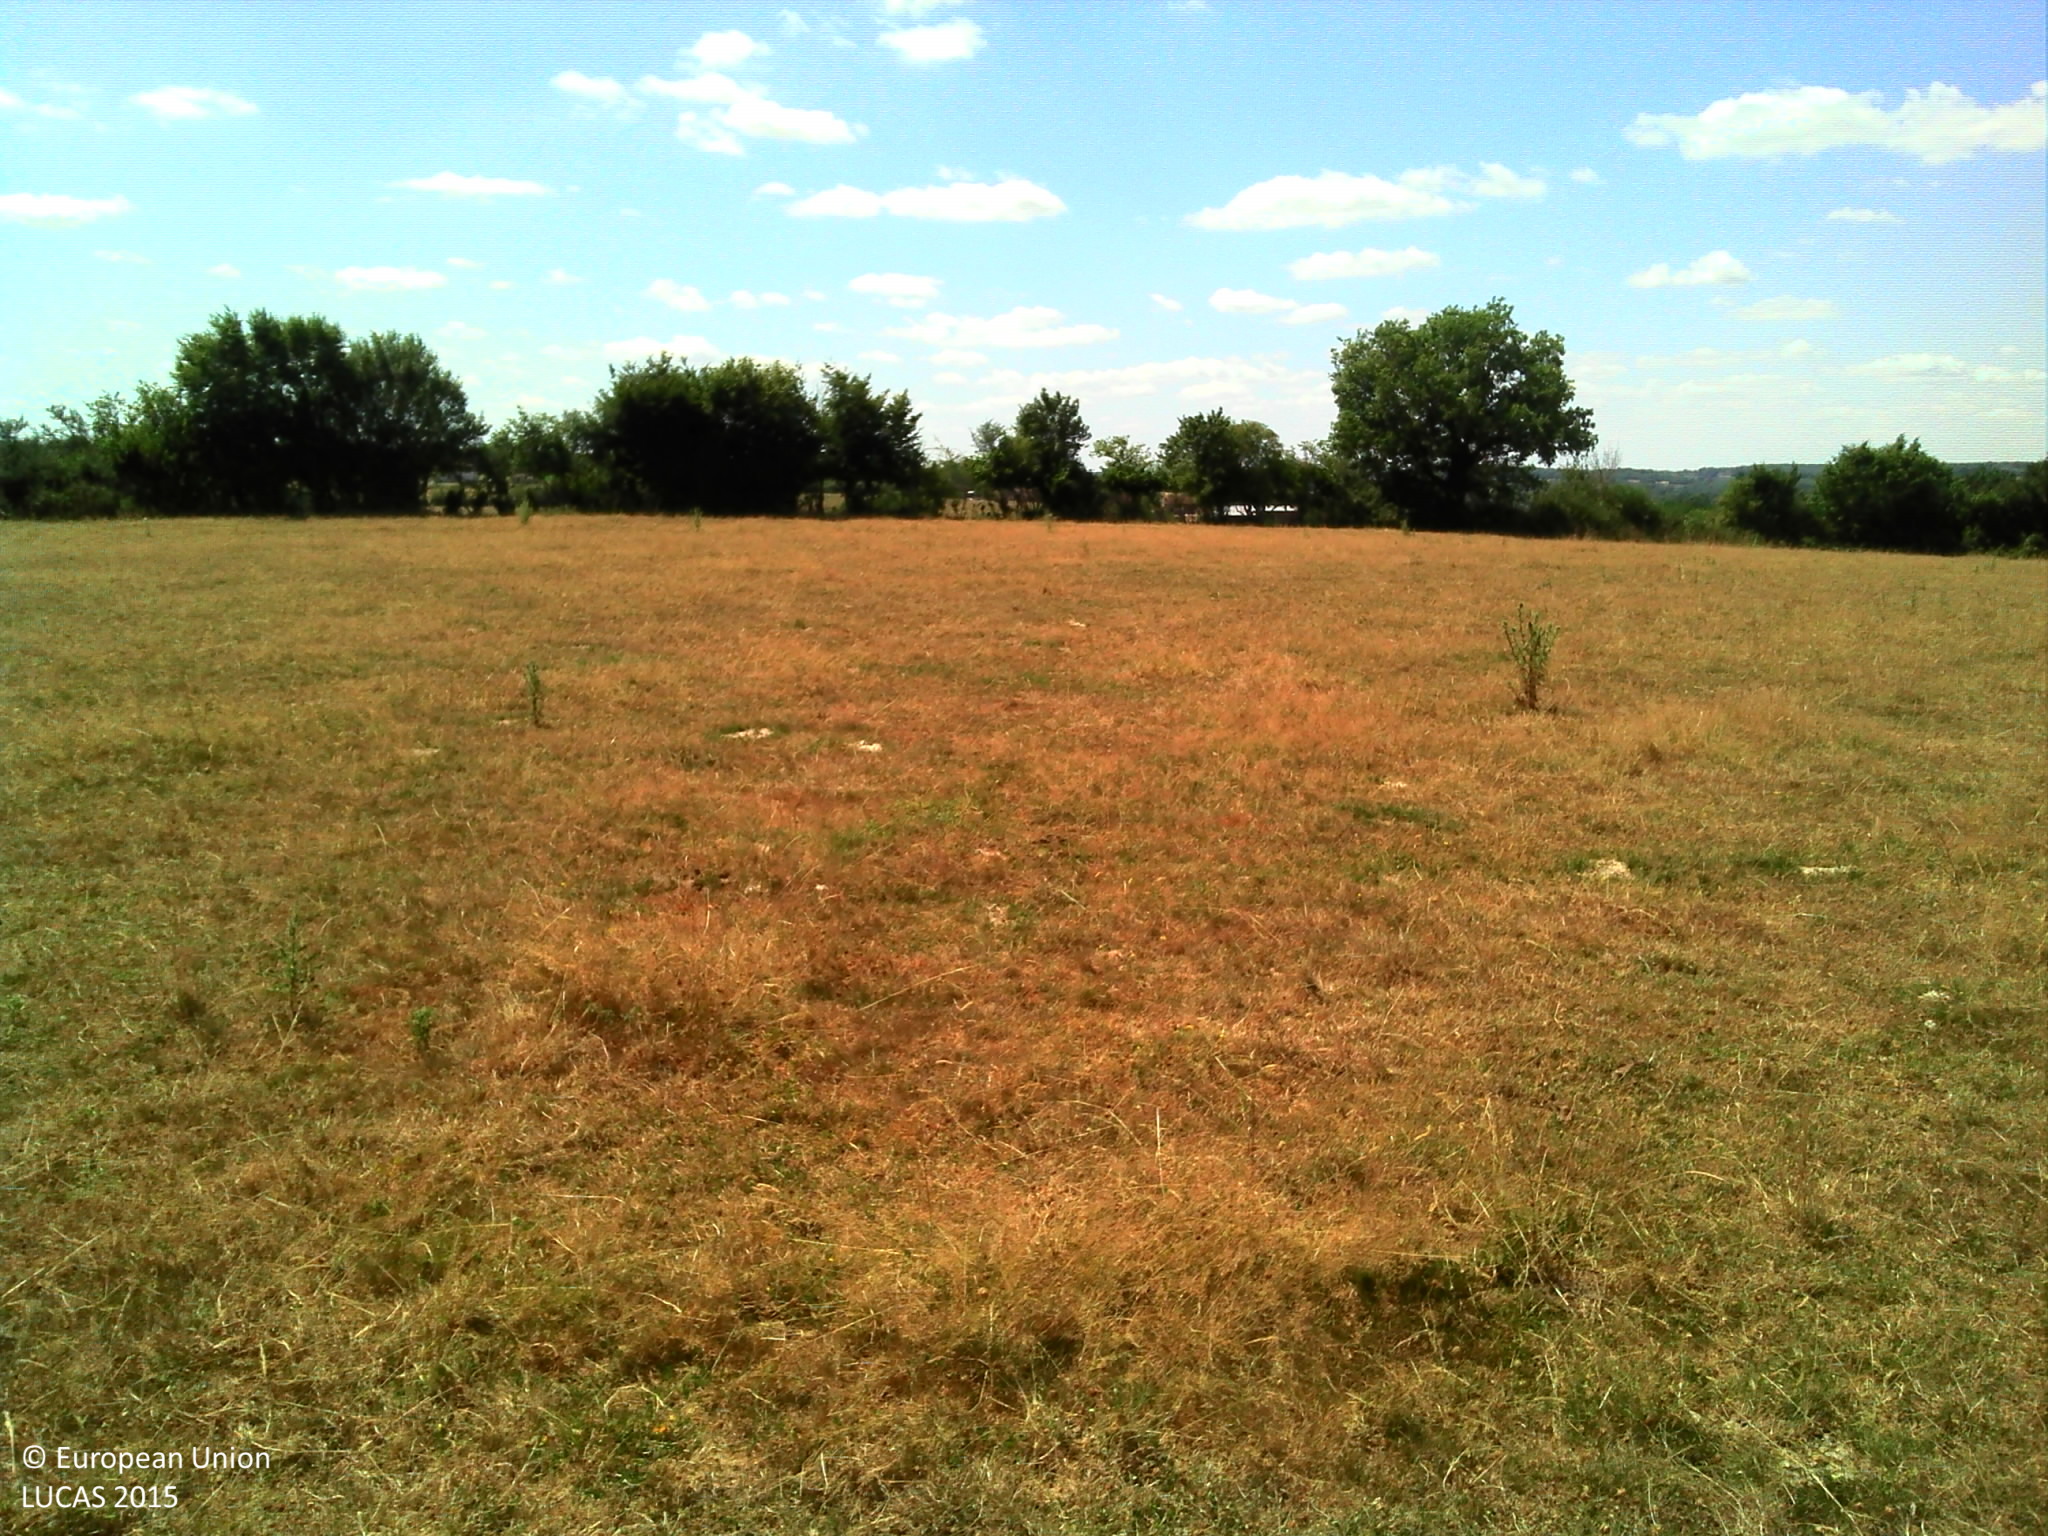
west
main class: Grassland
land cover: Grassland without tree/shrub cover
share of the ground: > 75 %
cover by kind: herbaceous plants 100 %
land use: Agriculture (excluding fallow land and kitchen gardens)
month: July
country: FR
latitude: 46.8482
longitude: 3.6380
